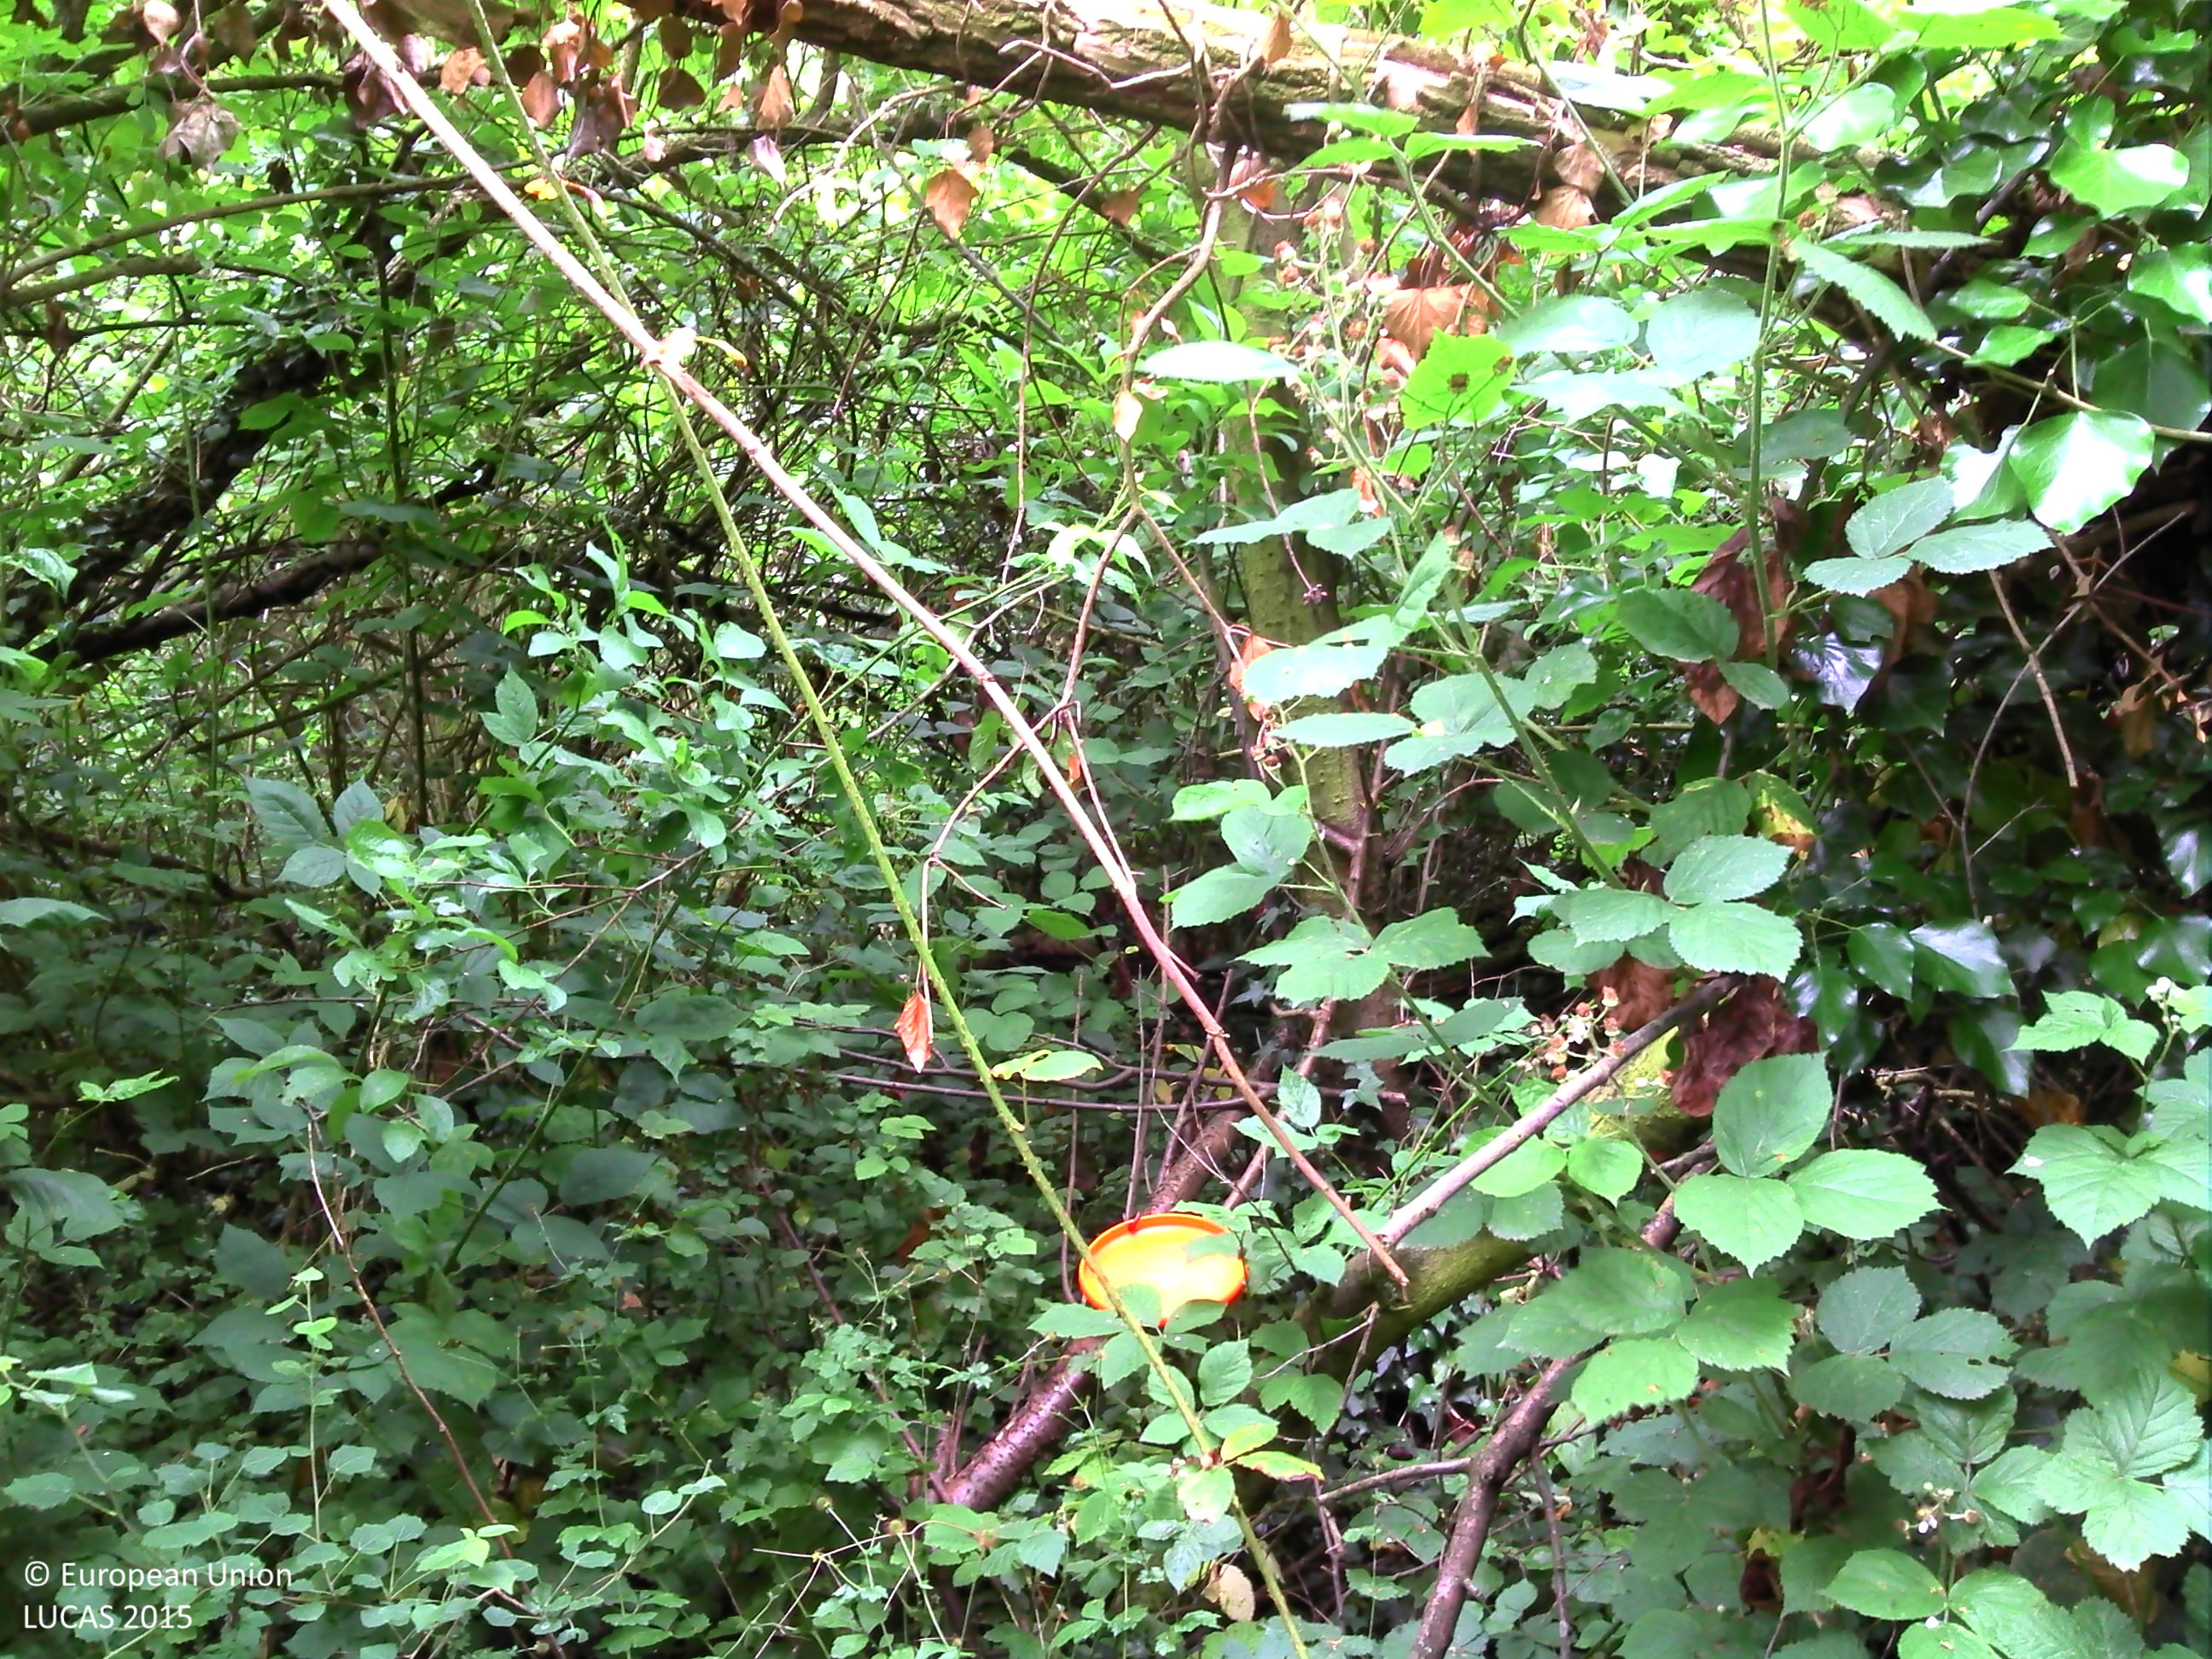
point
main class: Woodland
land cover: Broadleaved woodland
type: non-riverine alder, birch or aspen forest
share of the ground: > 75 %
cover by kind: broadleaved forest trees 60 %, herbaceous plants 40 %
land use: Semi-natural and natural areas not in use
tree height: > 5 m
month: June
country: BE
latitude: 50.6195
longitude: 5.5460
